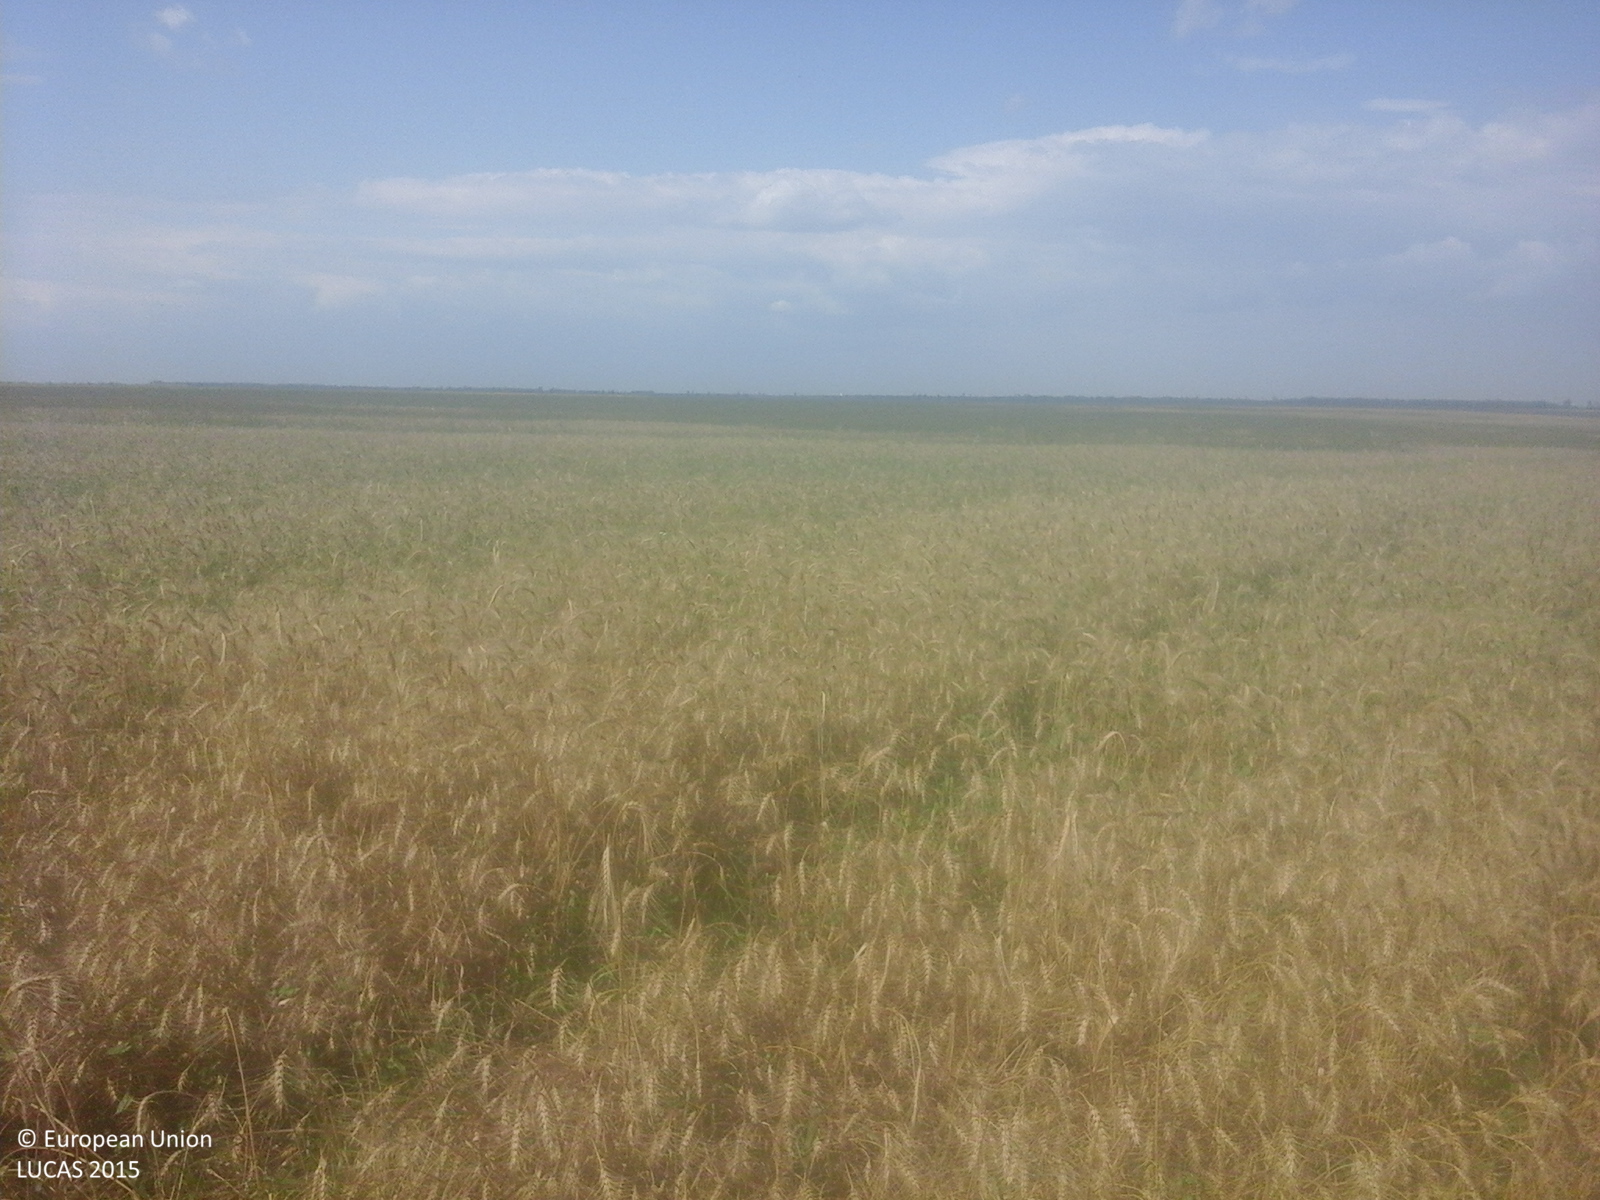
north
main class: Cropland
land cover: Common wheat
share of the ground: > 75 %
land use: Agriculture (excluding fallow land and kitchen gardens)
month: July
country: RO
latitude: 44.0747
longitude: 25.5087
